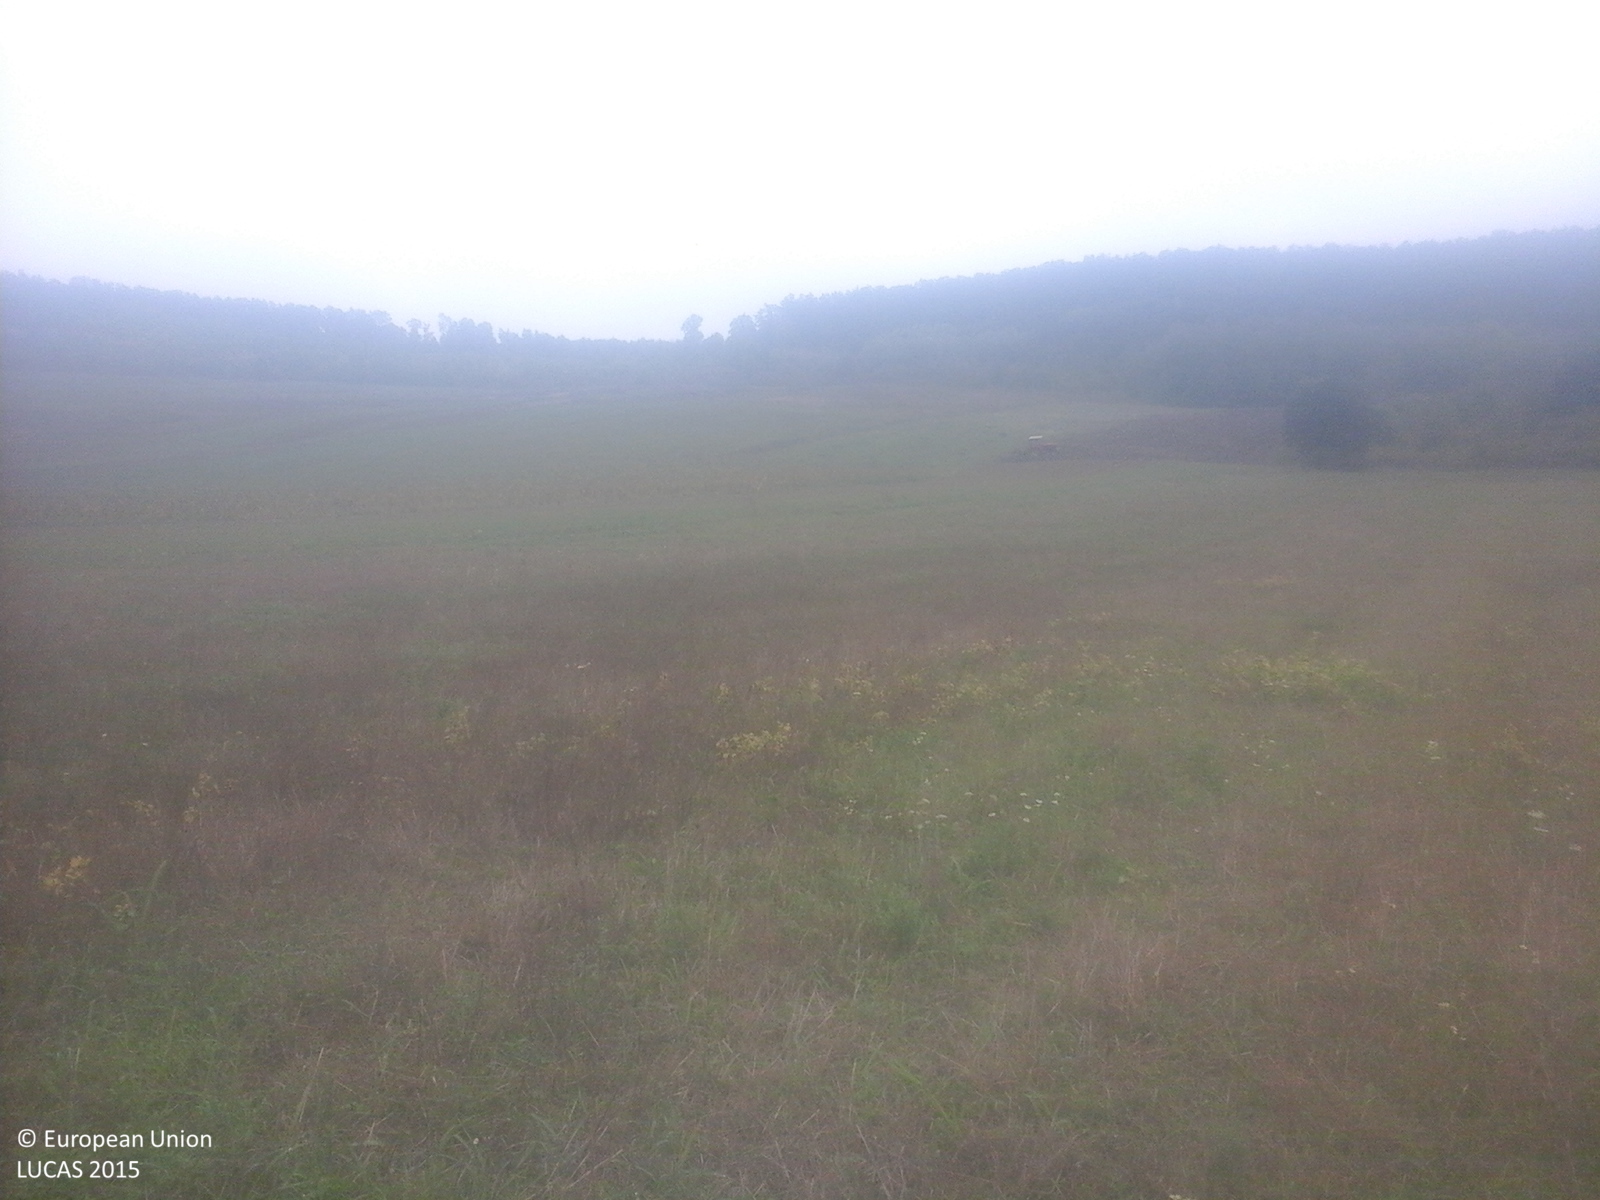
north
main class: Grassland
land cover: Spontaneously vegetated surfaces
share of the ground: > 75 %
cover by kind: herbaceous plants 100 %
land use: Fallow land
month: September
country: RO
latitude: 44.7382
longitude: 23.2480
